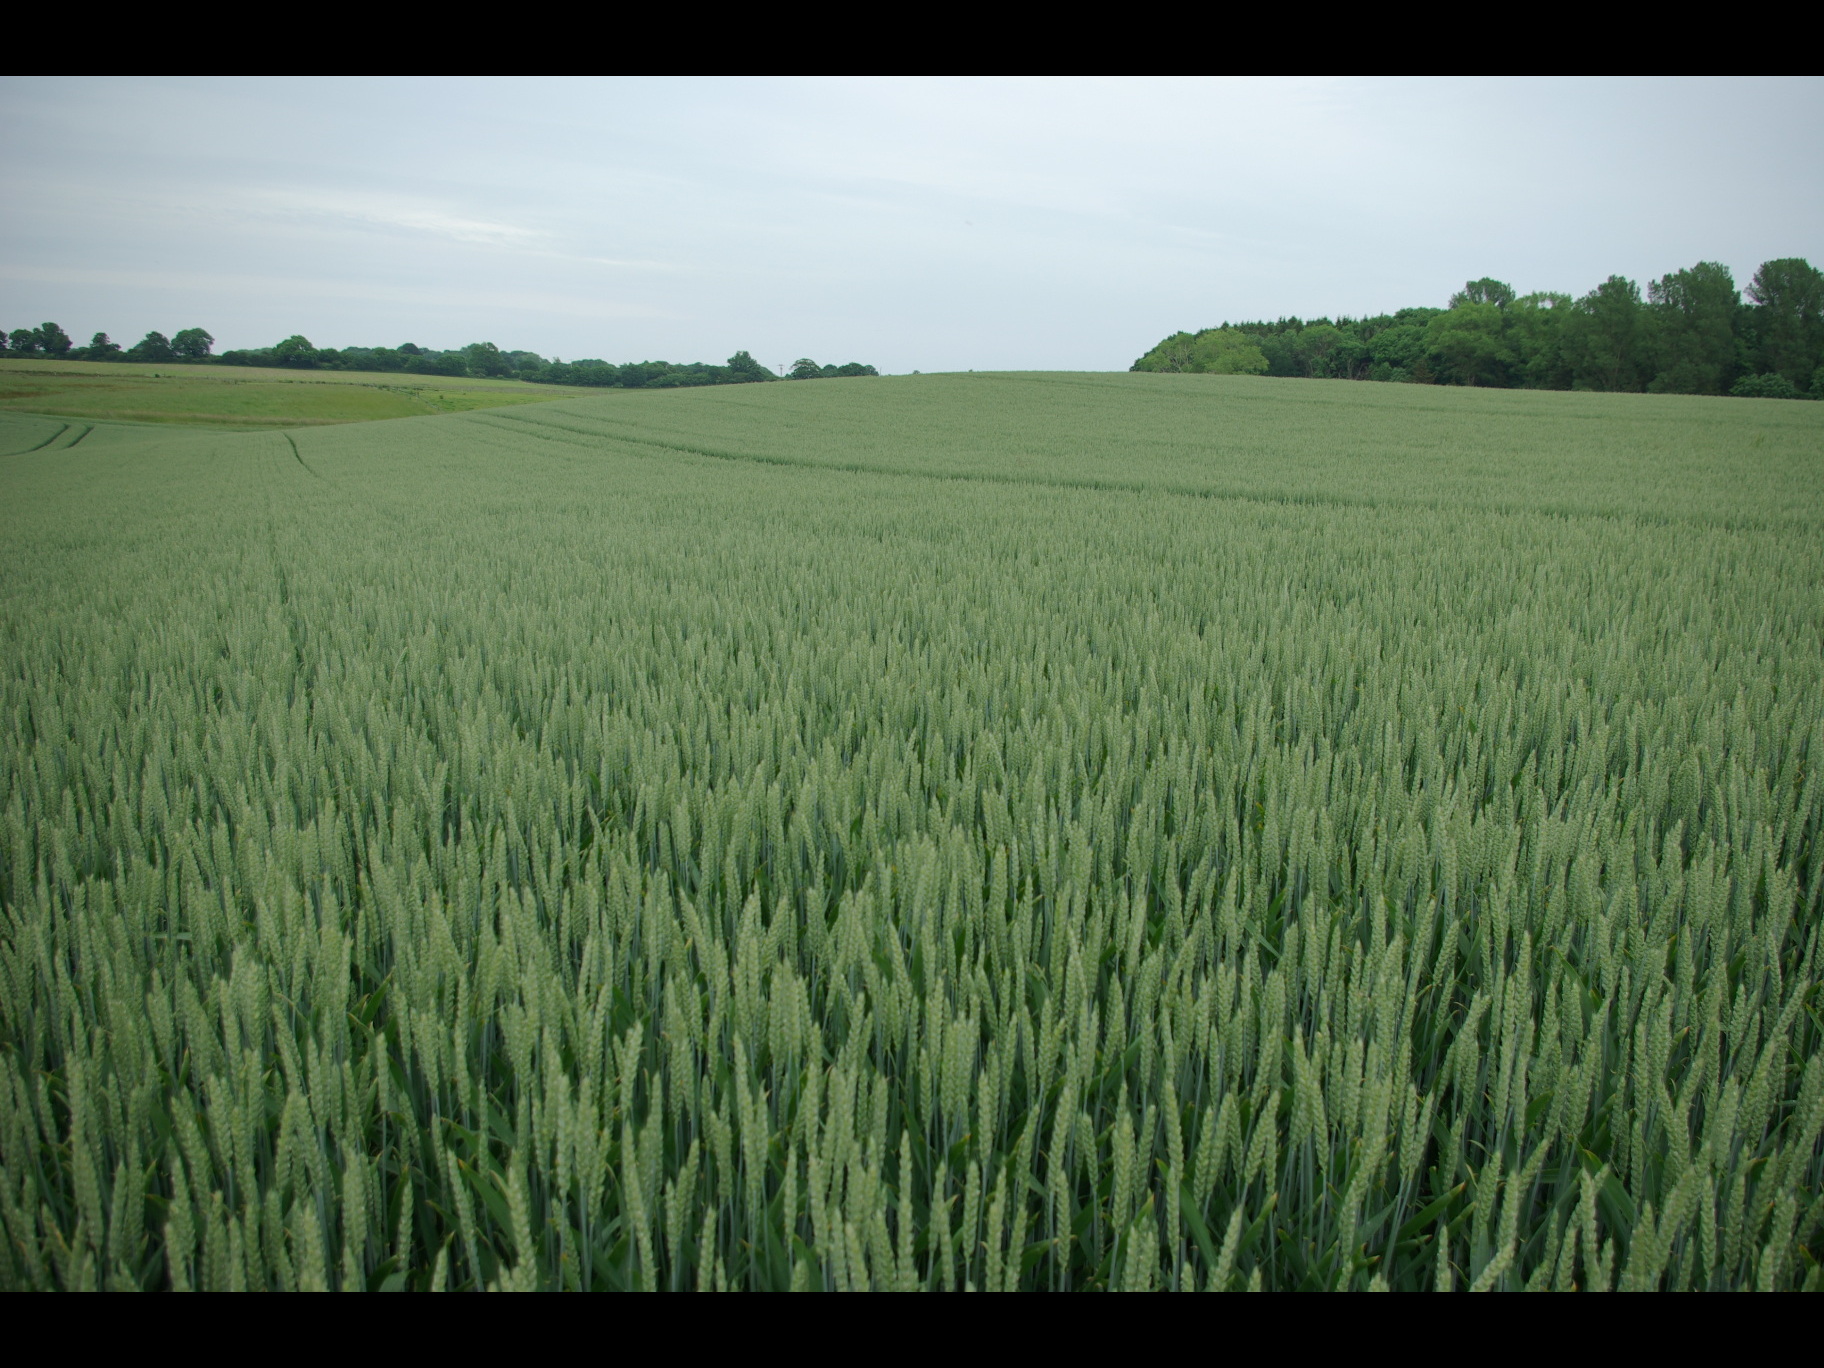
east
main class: Cropland
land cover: Common wheat
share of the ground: > 75 %
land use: Agriculture (excluding fallow land and kitchen gardens)
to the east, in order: Common wheat; Spontaneously vegetated surfaces; Fences; Artificial constructions; Other bare soil; Fences; Shruby margins; Tracks; Spontaneously vegetated surfaces; Ditches and canals; Spontaneously vegetated surfaces; Fences; Grassland without tree/shrub cover
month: June
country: DE
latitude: 54.5162
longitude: 9.9228
